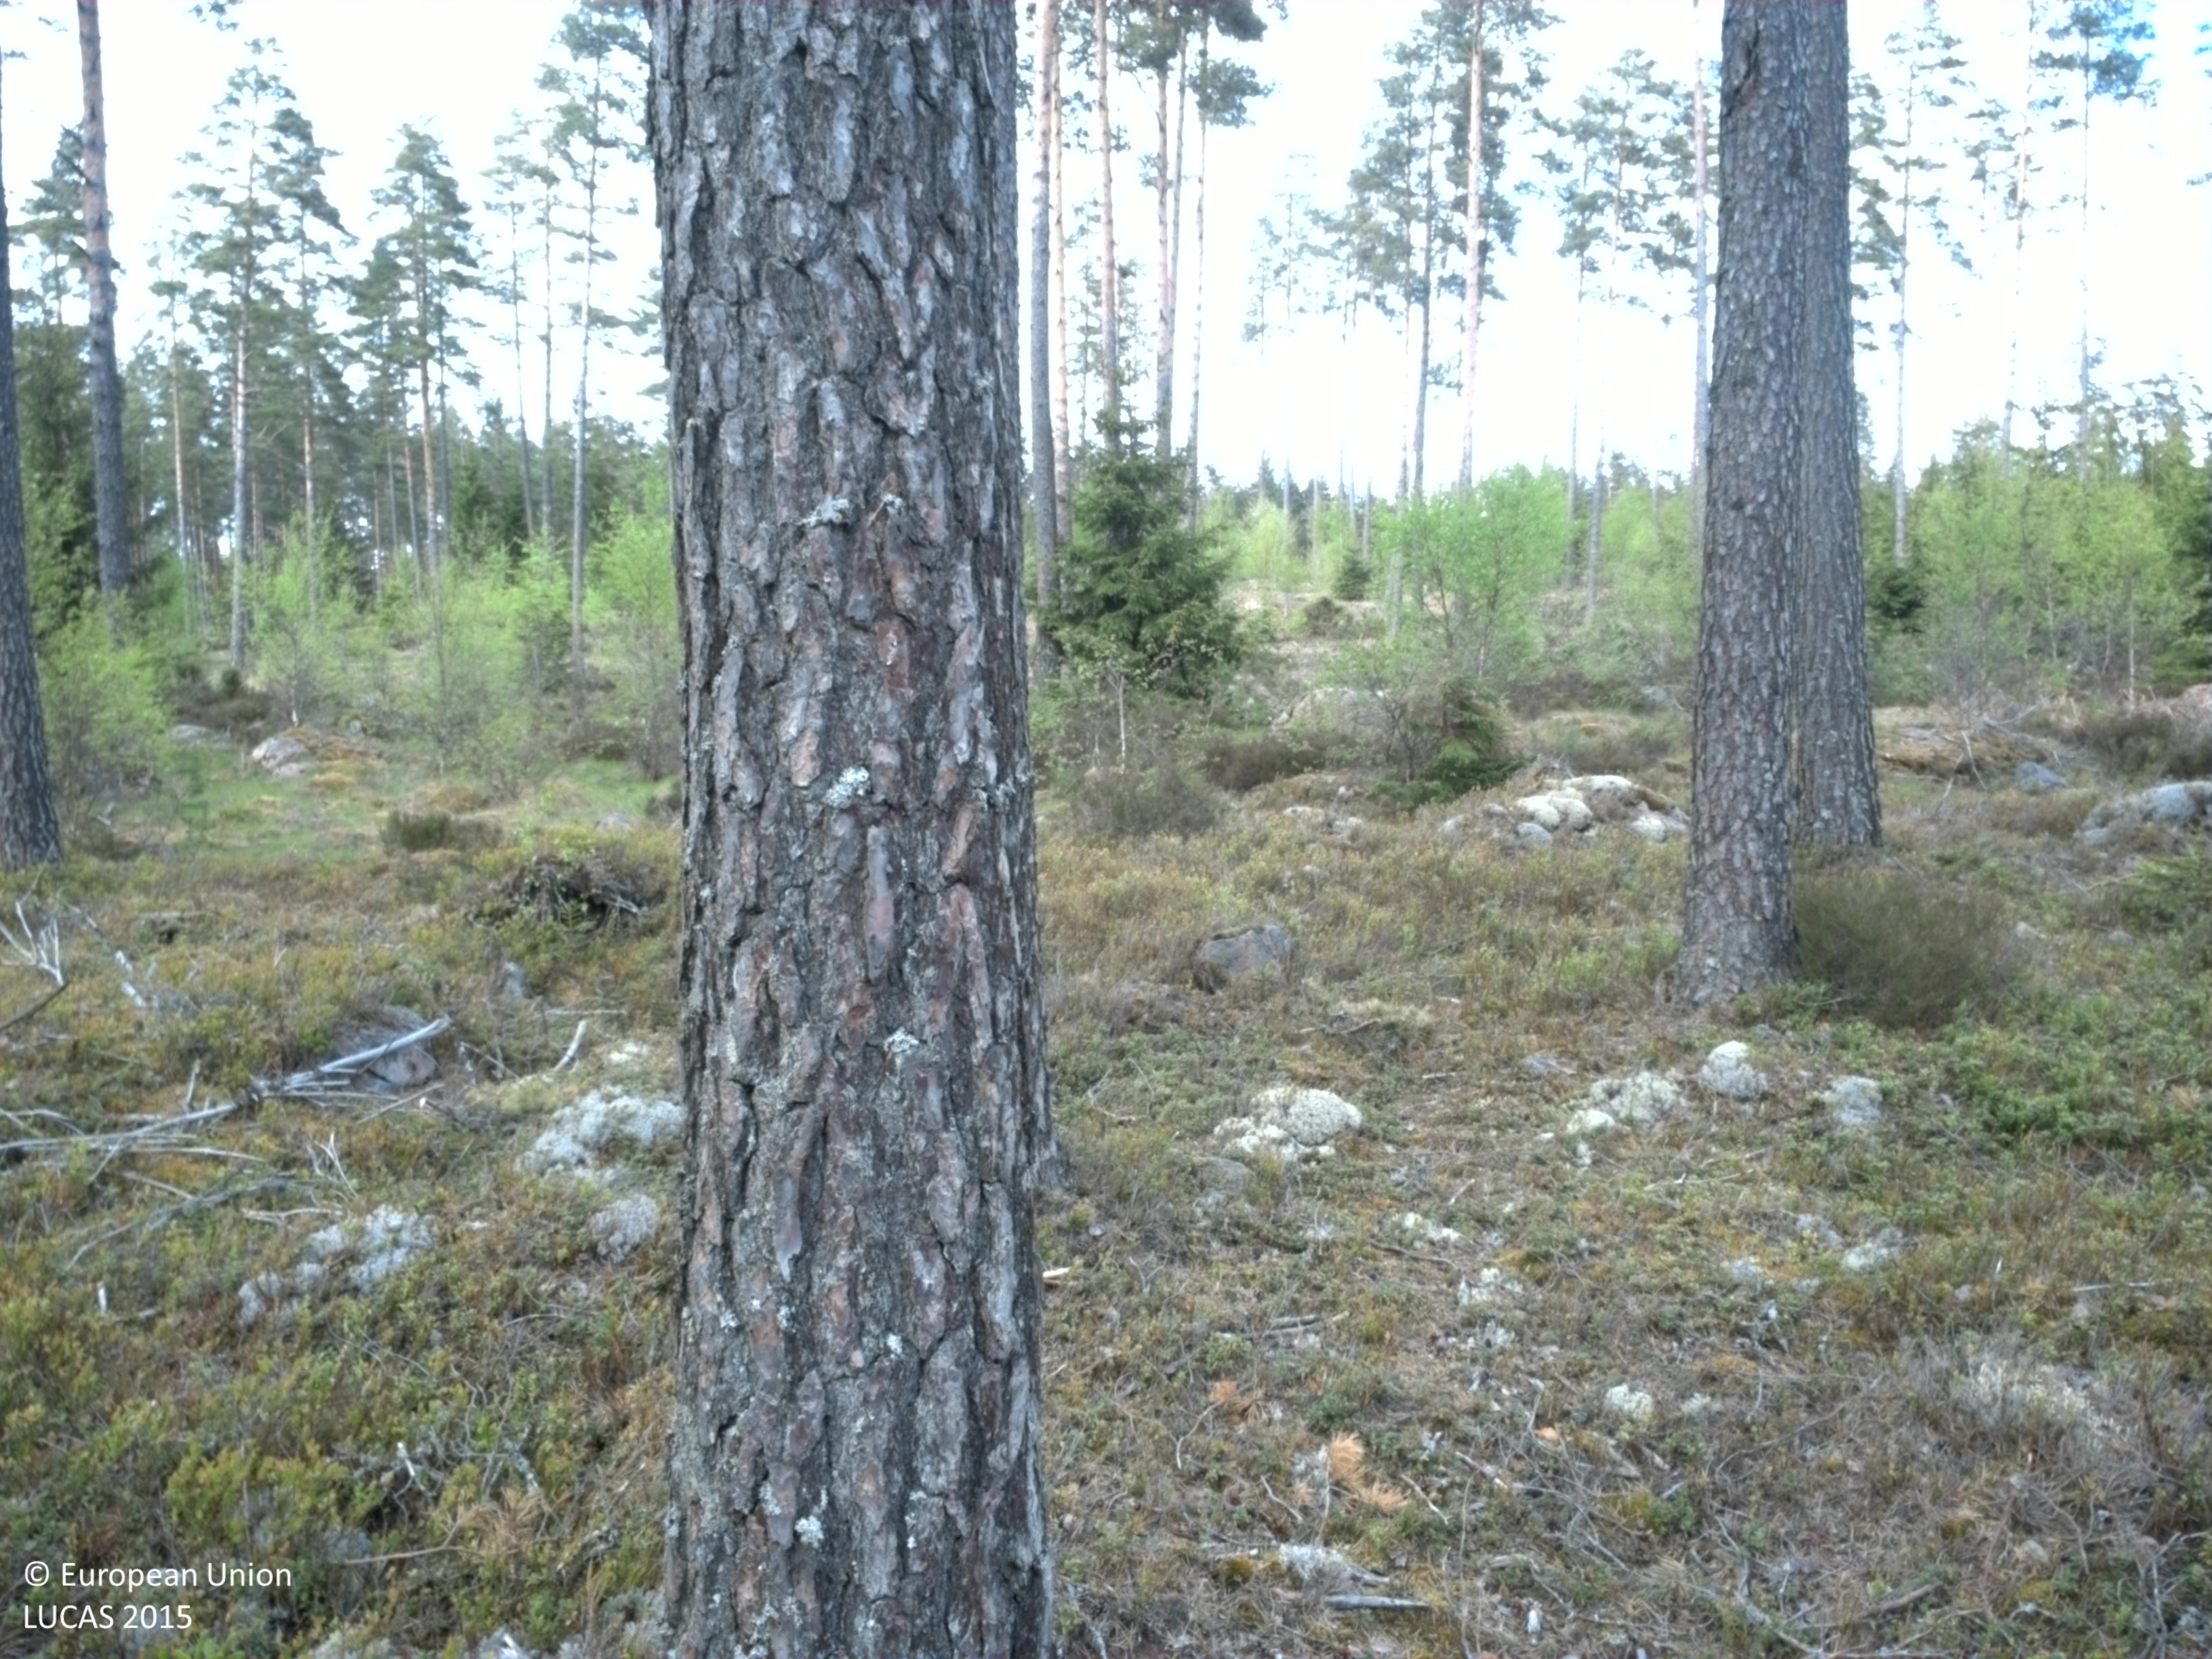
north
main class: Woodland
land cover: Pine dominated coniferous woodland
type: boreal forest
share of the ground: 25 - 50 %
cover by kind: coniferous forest trees 50 %, shrubs 25 %, lichens and mosses 25 %
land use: Forestry
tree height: > 5 m
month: May
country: SE
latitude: 56.8866
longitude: 15.3649
